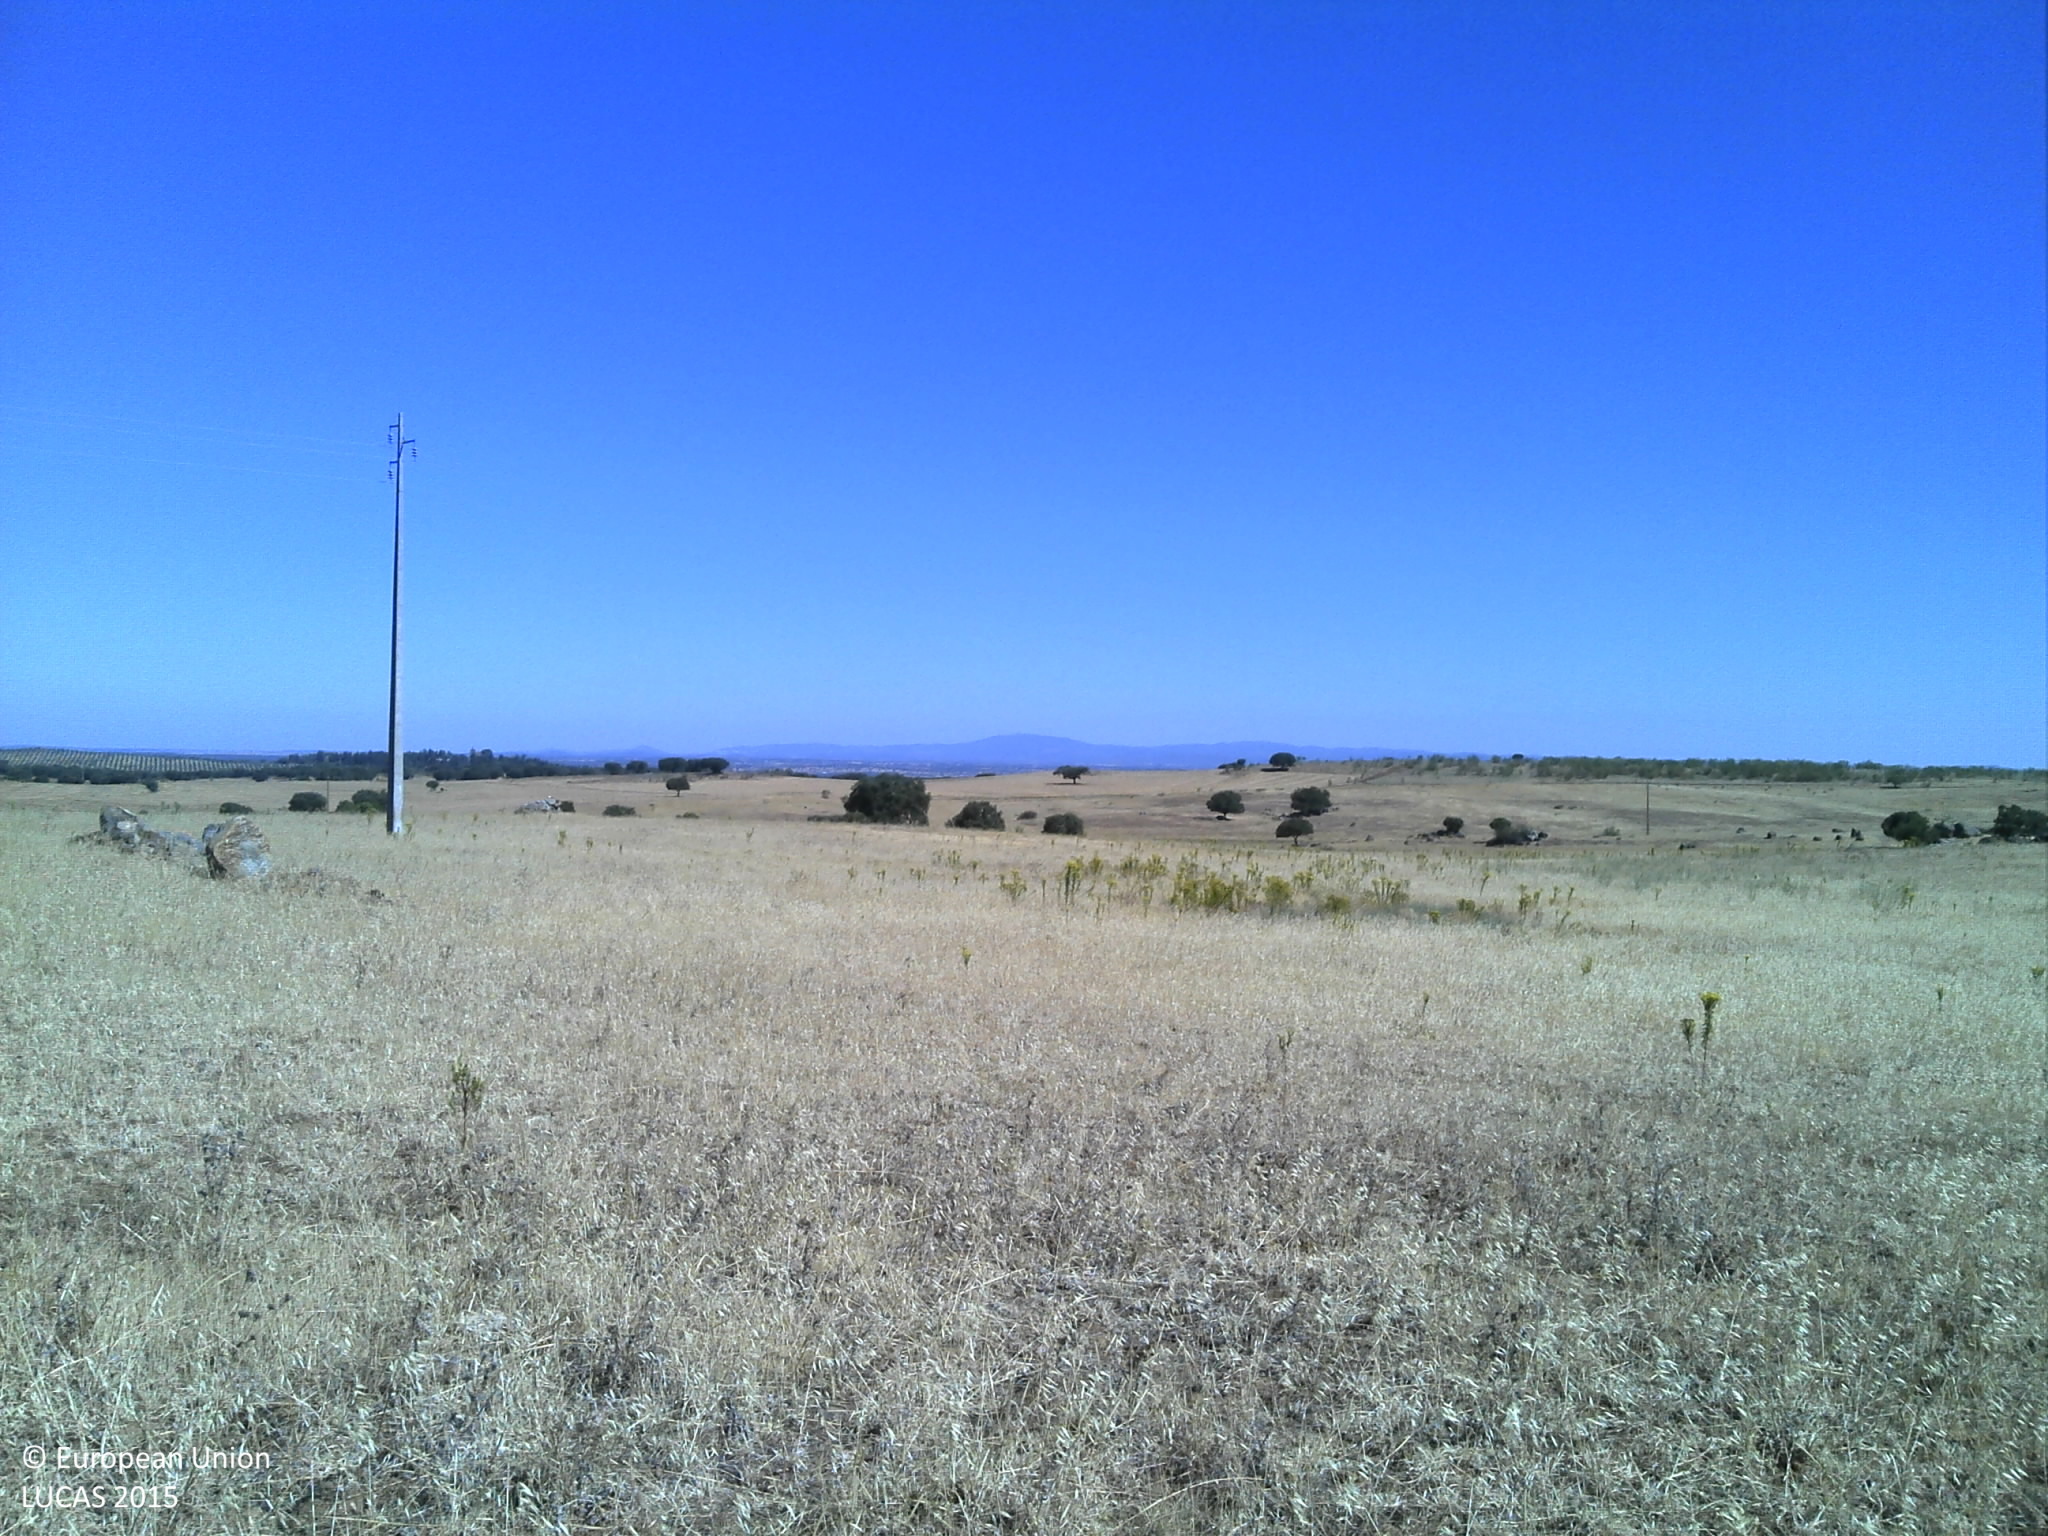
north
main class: Grassland
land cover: Grassland without tree/shrub cover
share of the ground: 10 - 25 %
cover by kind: unconsolidated bare surface 85 %, herbaceous plants 15 %
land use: Agriculture (excluding fallow land and kitchen gardens)
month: July
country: PT
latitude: 38.9600
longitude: -7.2847
